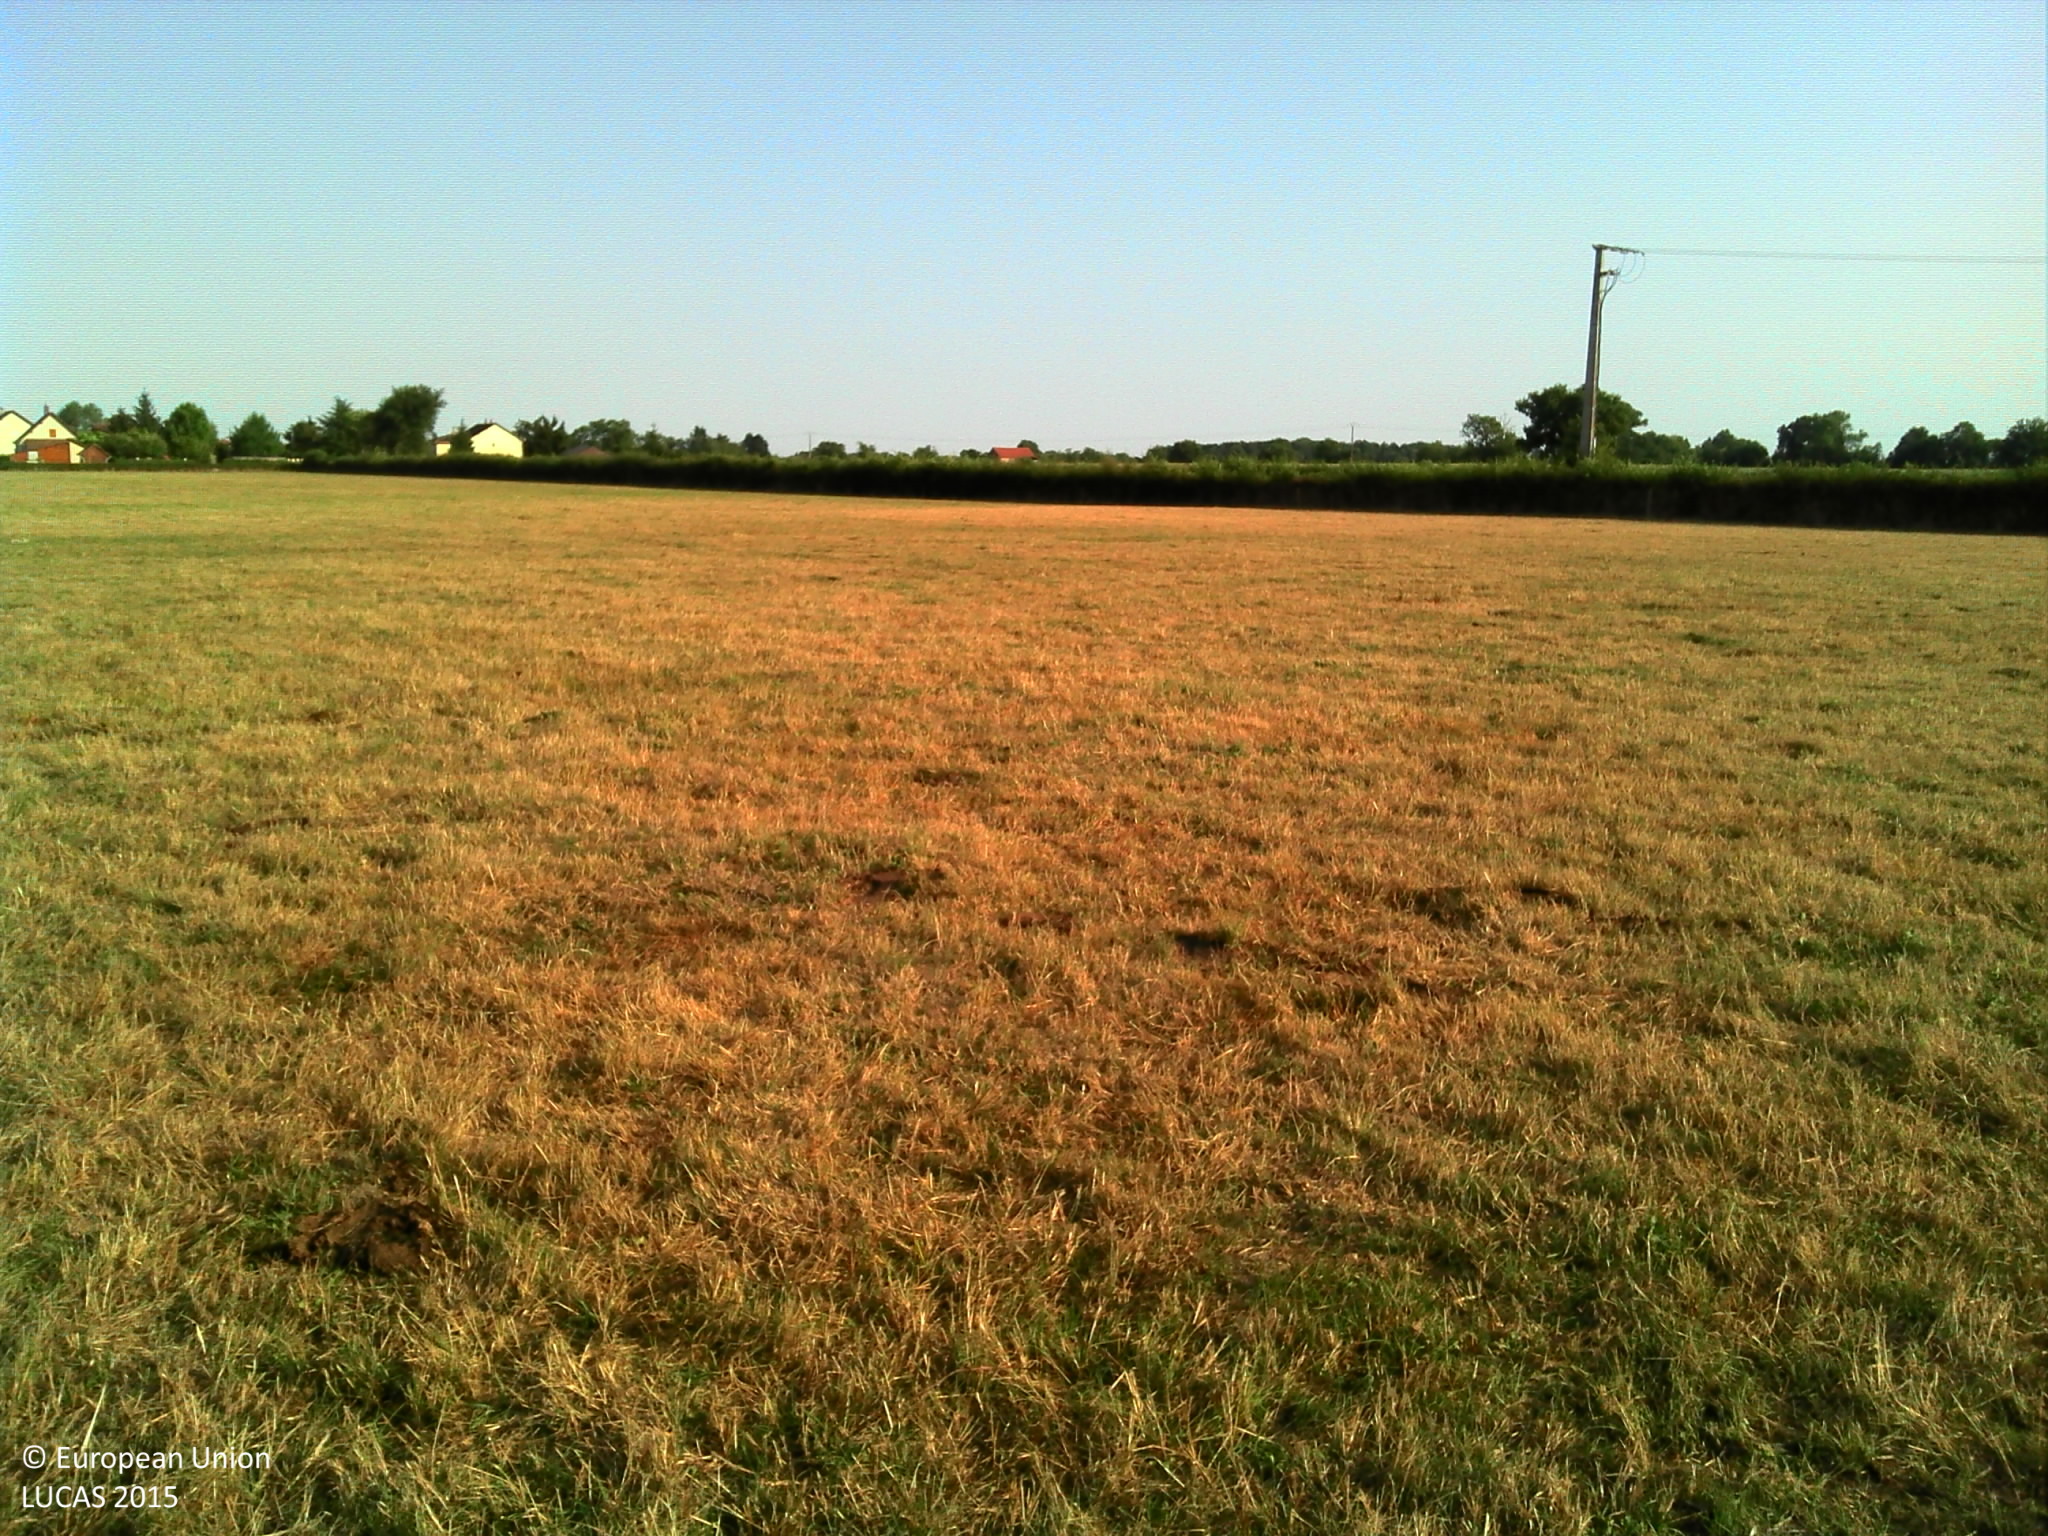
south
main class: Grassland
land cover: Grassland without tree/shrub cover
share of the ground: > 75 %
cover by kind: herbaceous plants 100 %
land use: Agriculture (excluding fallow land and kitchen gardens)
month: July
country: FR
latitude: 46.7749
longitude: 3.6206
